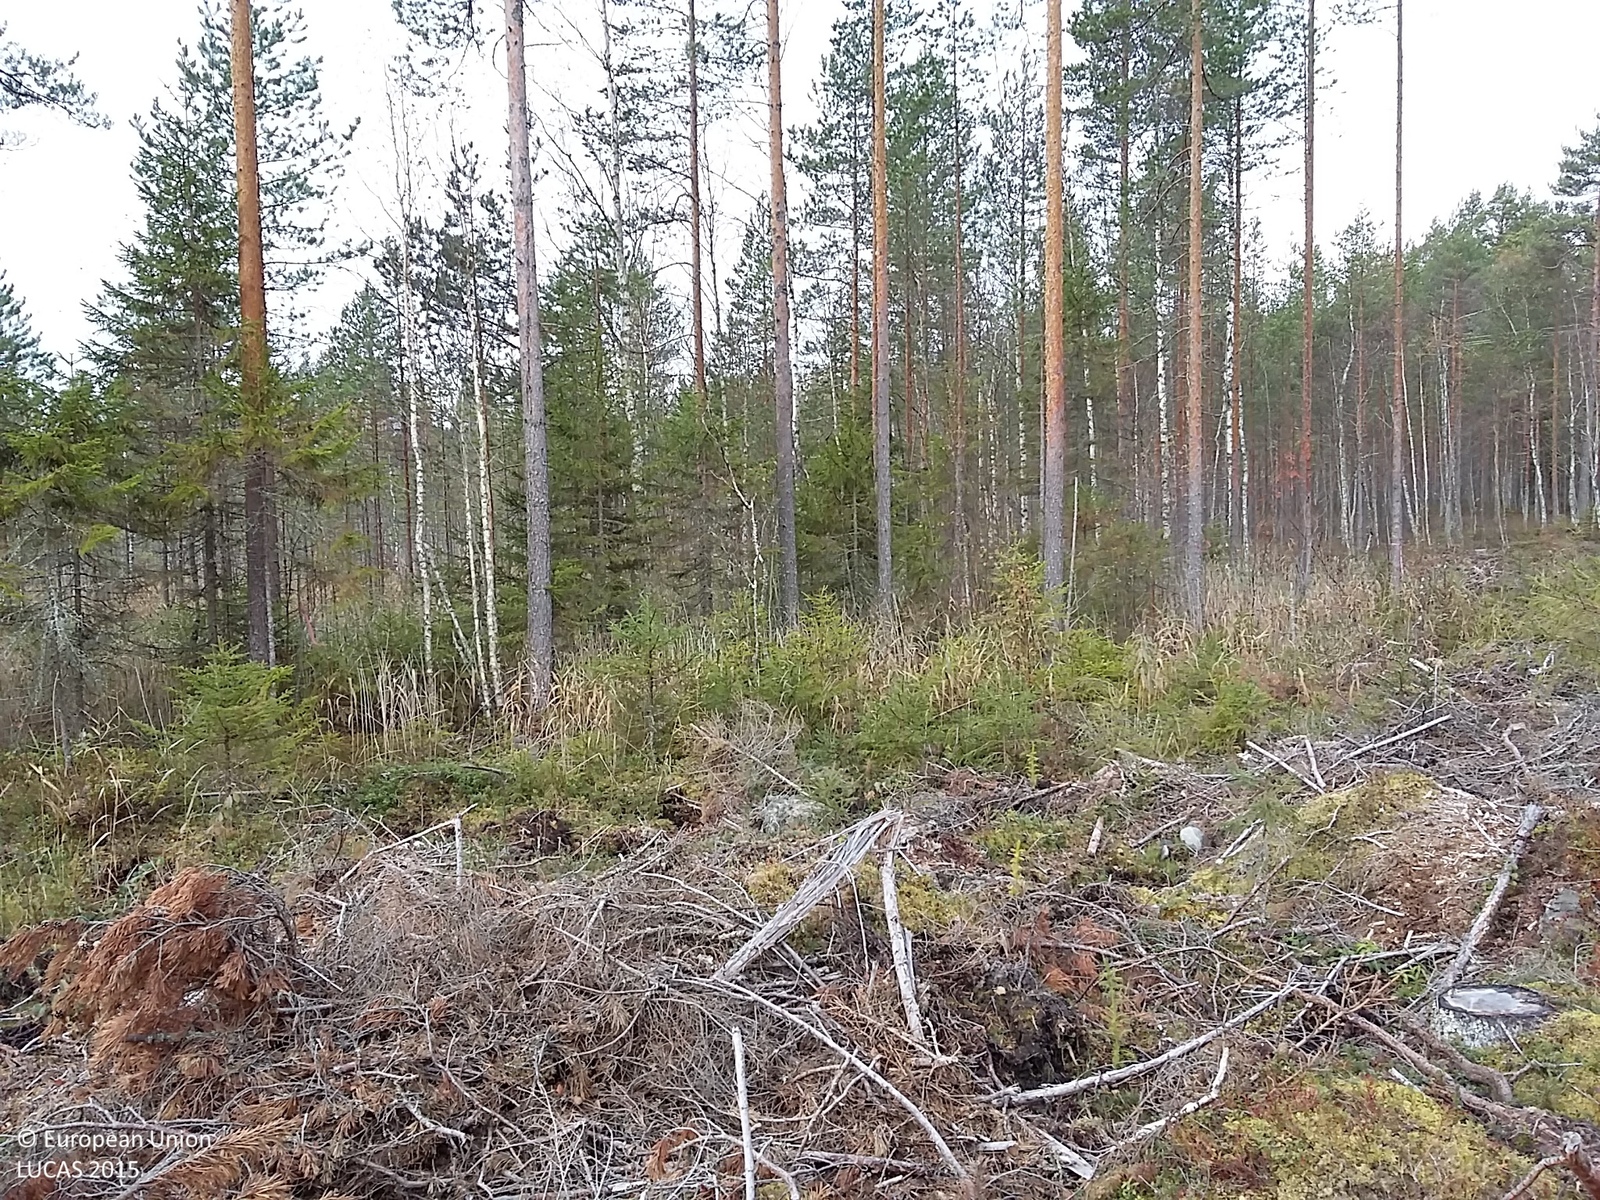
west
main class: Shrubland
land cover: Shrubland with sparse tree cover
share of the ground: 10 - 25 %
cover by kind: lichens and mosses 35 %, unconsolidated bare surface 25 %, shrubs 15 %, coniferous forest trees 5 %, herbaceous plants 5 %, consolidated bare surface 5 %
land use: Forestry
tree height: < 5 m
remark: Clear cut
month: October
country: FI
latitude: 62.5132
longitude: 26.2701
